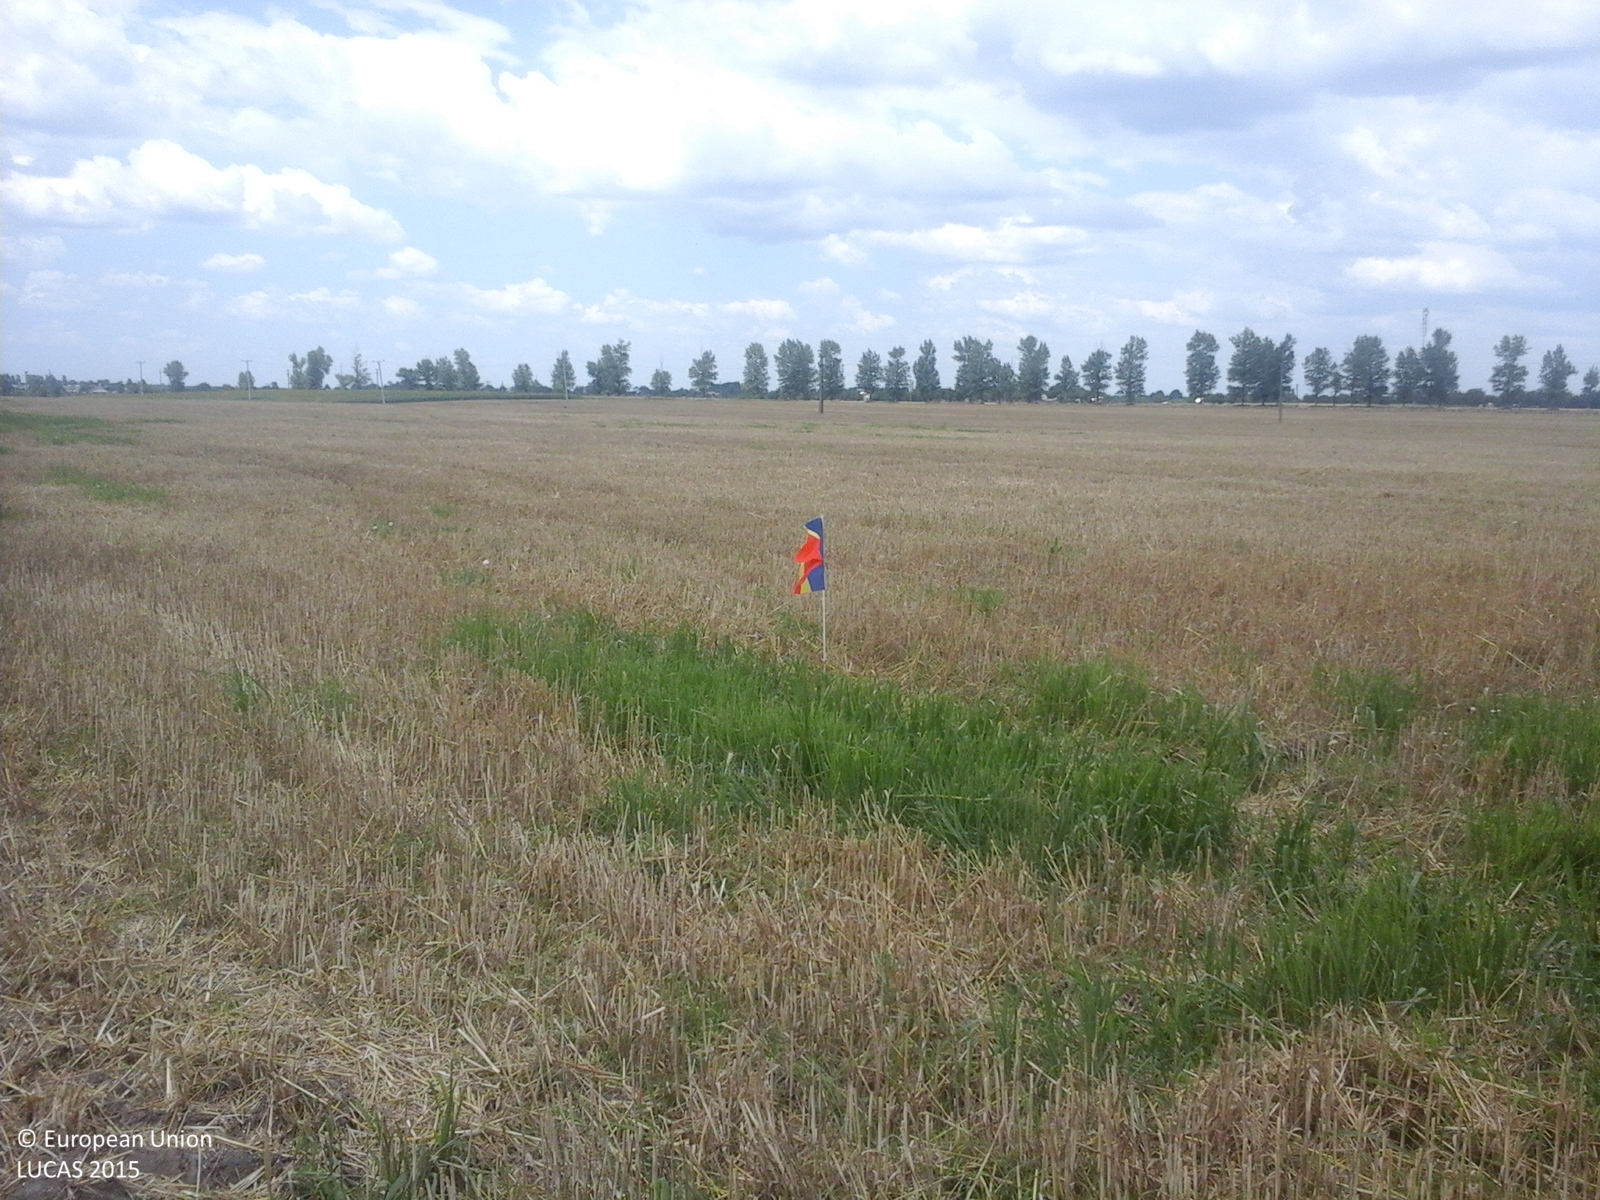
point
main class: Cropland
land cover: Common wheat
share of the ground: < 10 %
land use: Agriculture (excluding fallow land and kitchen gardens)
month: July
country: RO
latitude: 44.3422
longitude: 24.9421
